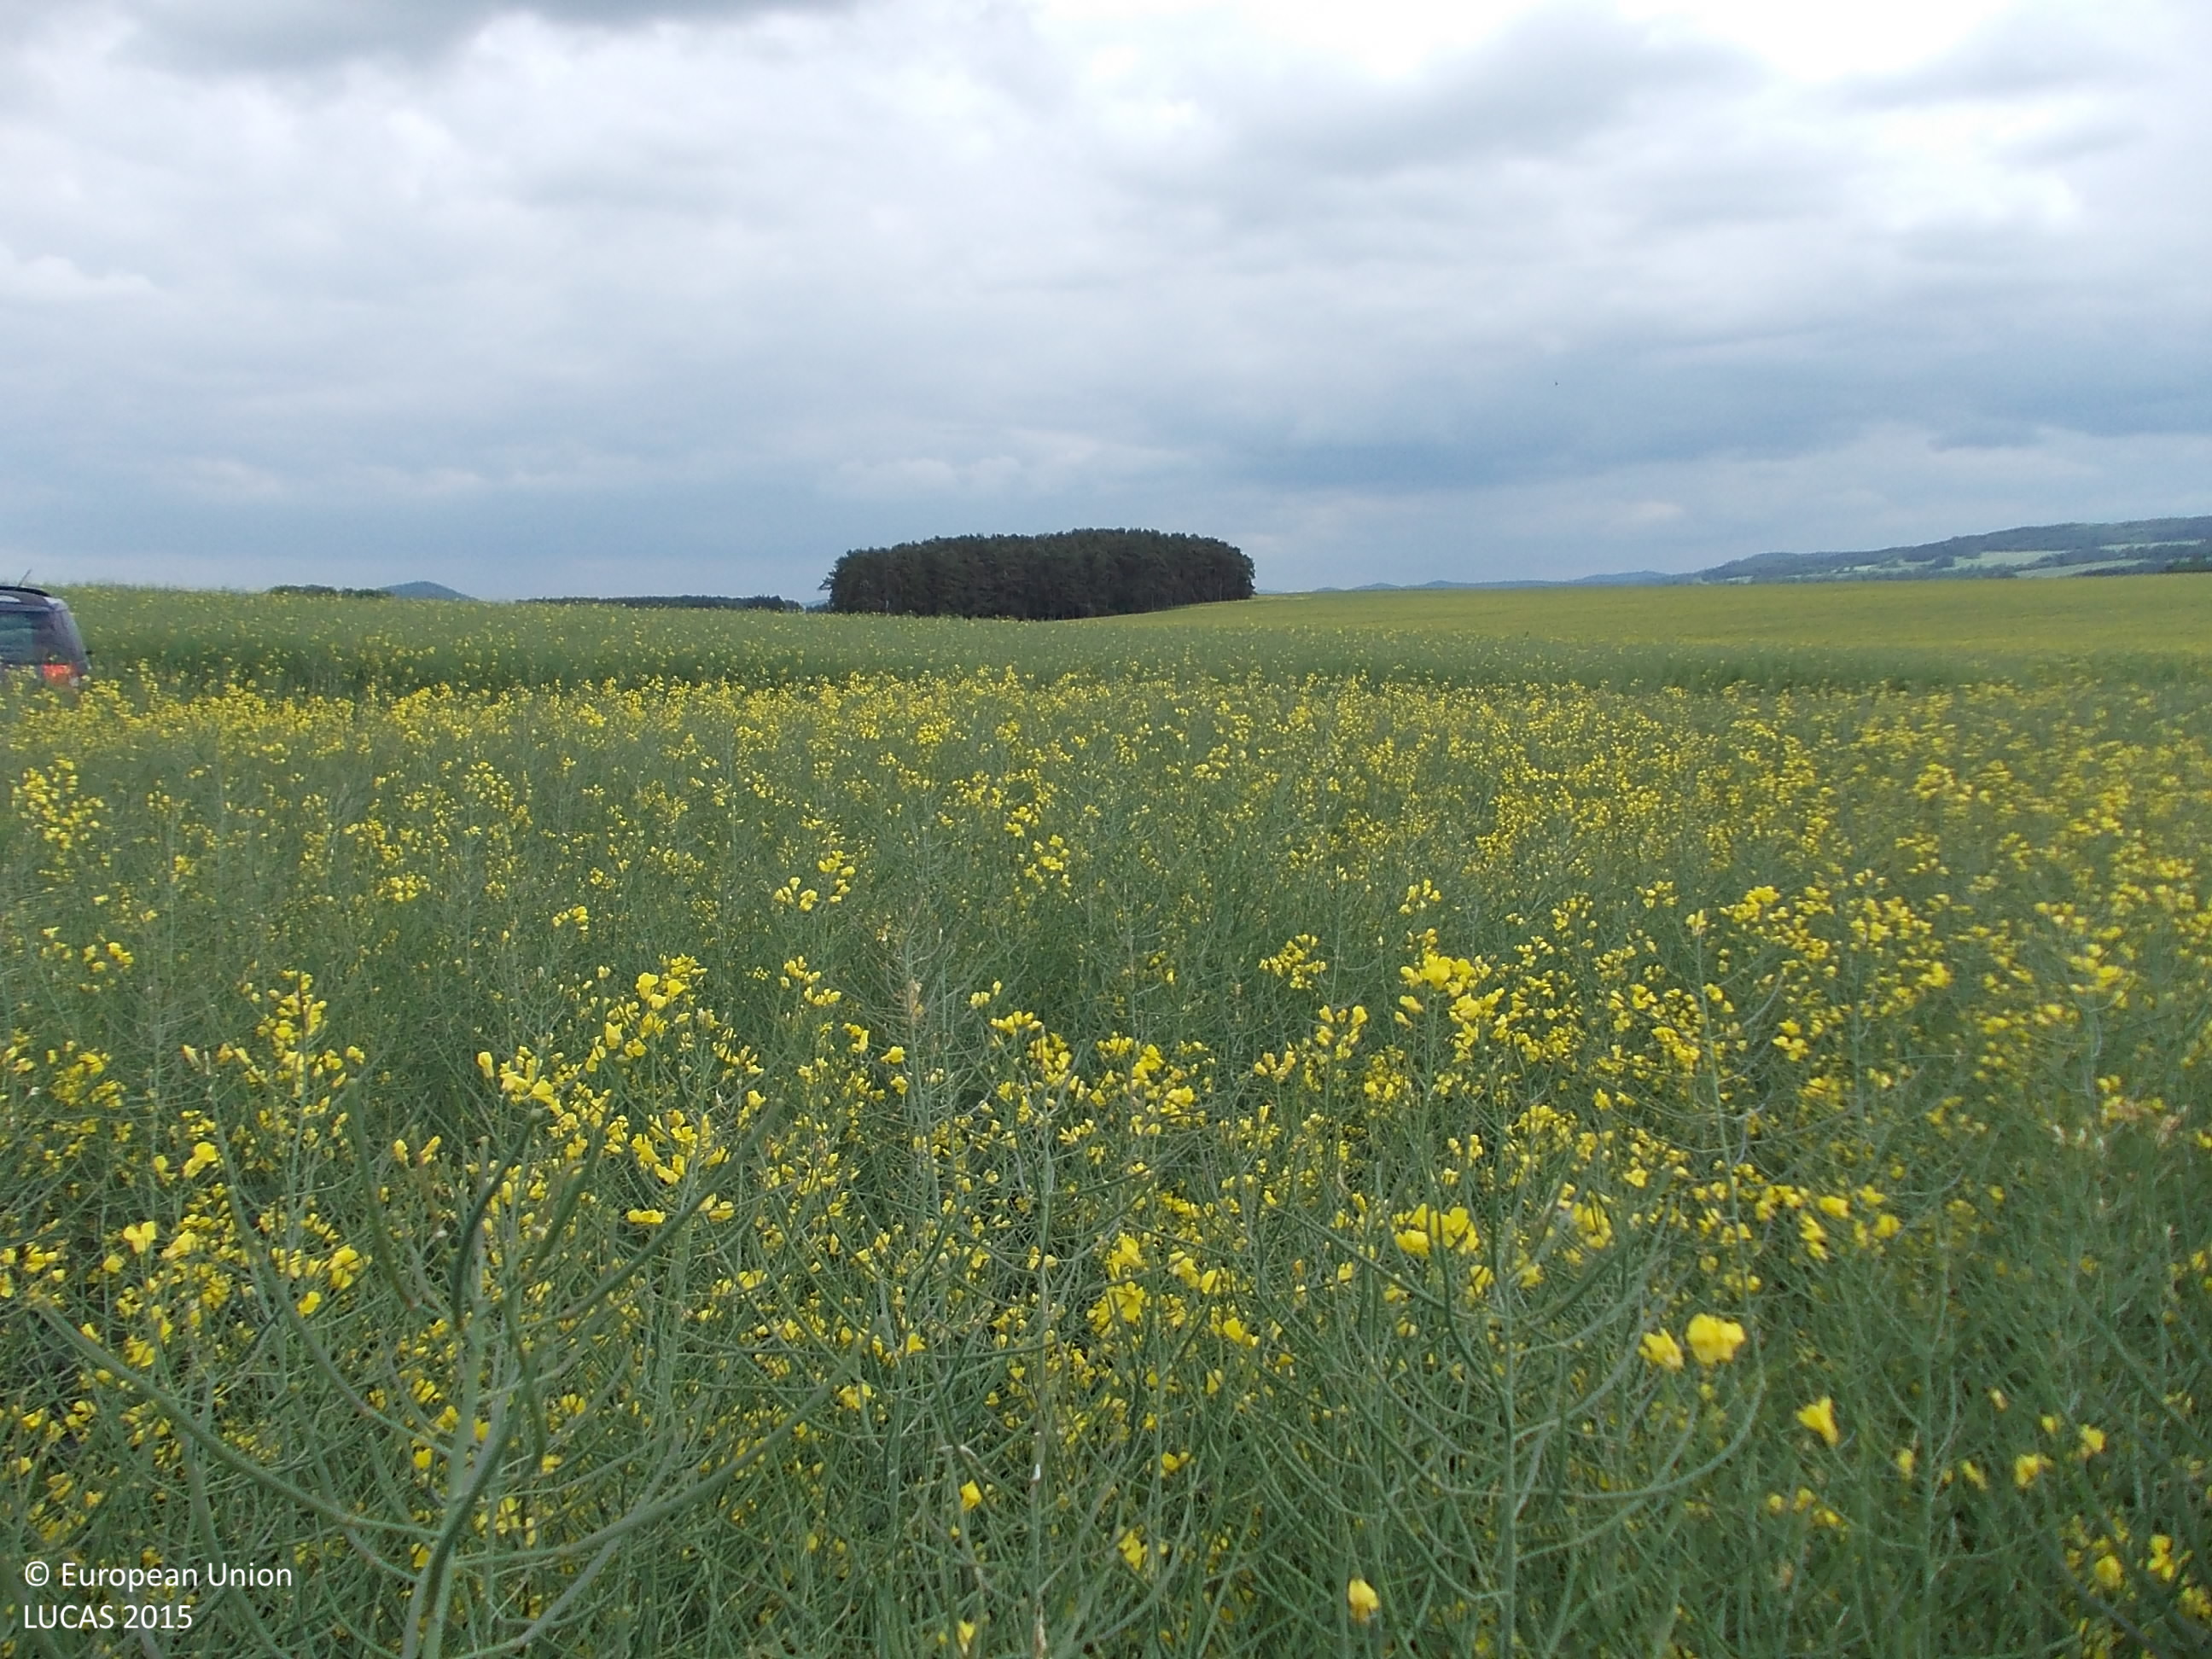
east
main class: Cropland
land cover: Rape and turnip rape
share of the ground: > 75 %
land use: Agriculture (excluding fallow land and kitchen gardens)
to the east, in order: Rape and turnip rape
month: May
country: CZ
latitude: 49.2754
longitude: 13.7802
